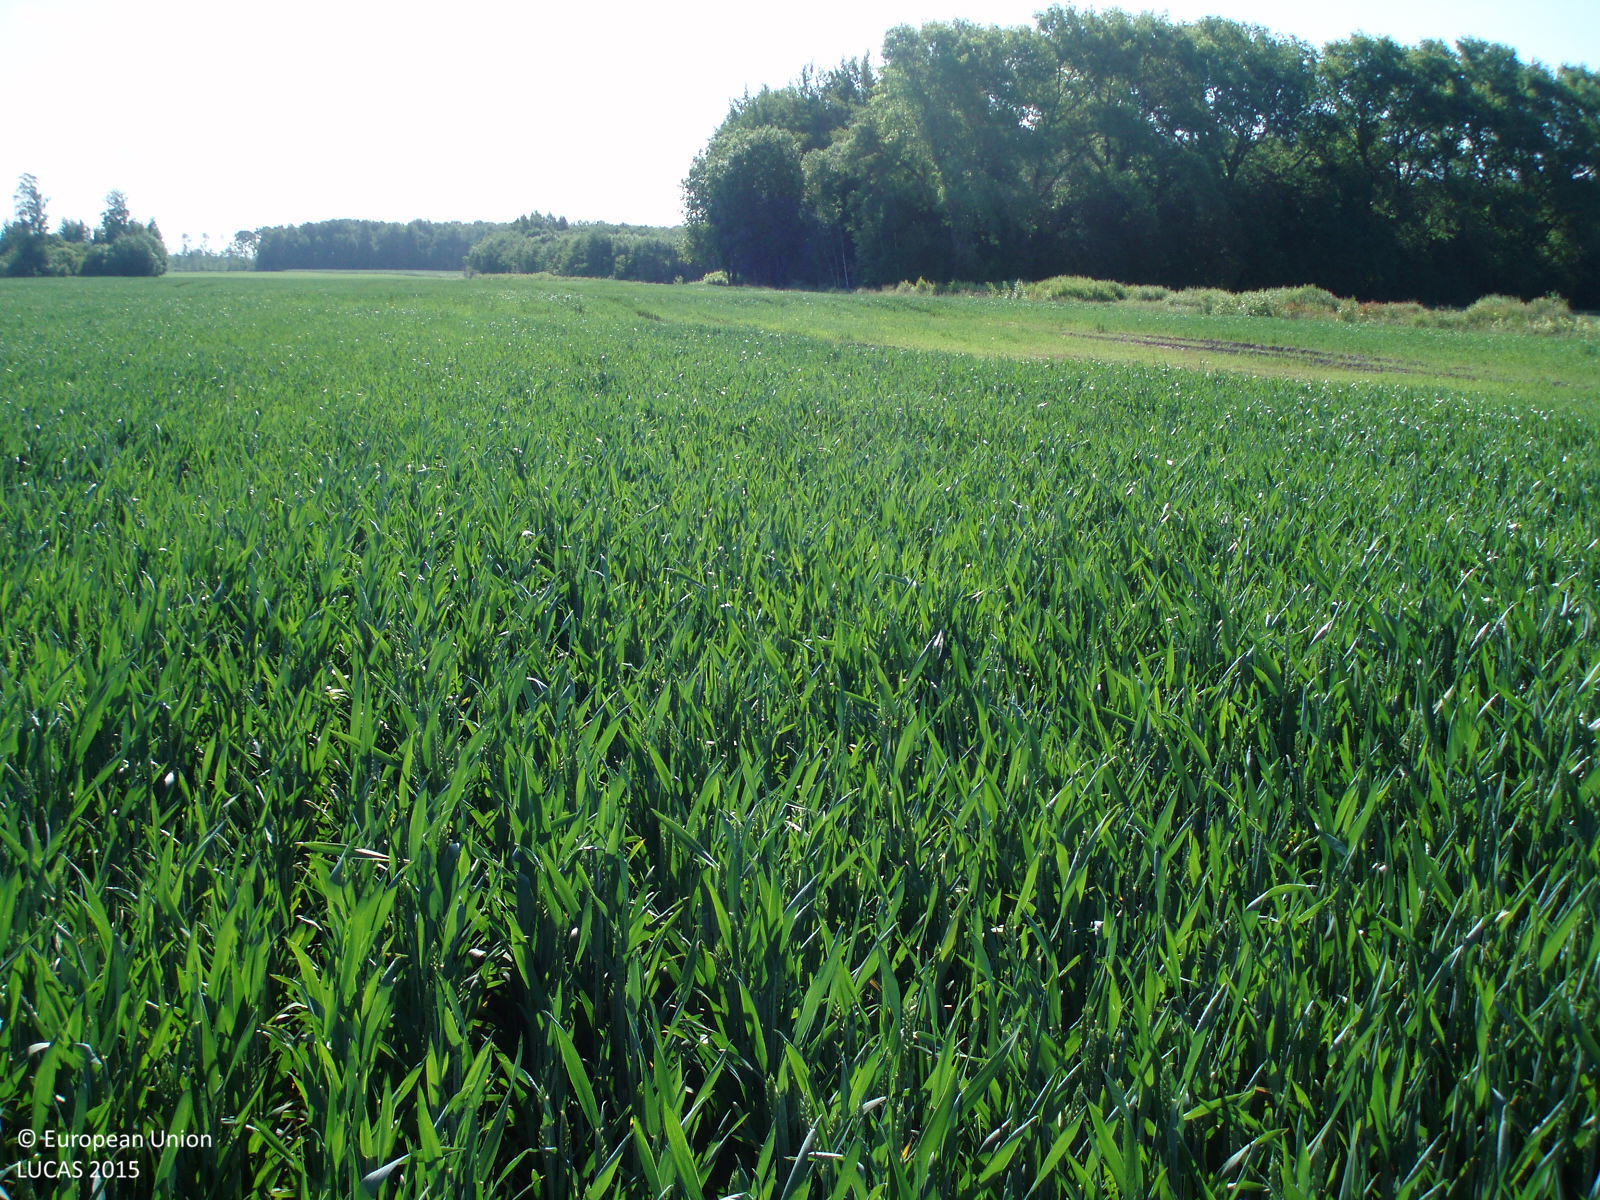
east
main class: Cropland
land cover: Common wheat
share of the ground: > 75 %
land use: Agriculture (excluding fallow land and kitchen gardens)
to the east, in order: Common wheat
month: June
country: LT
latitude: 55.1994
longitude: 22.7769
